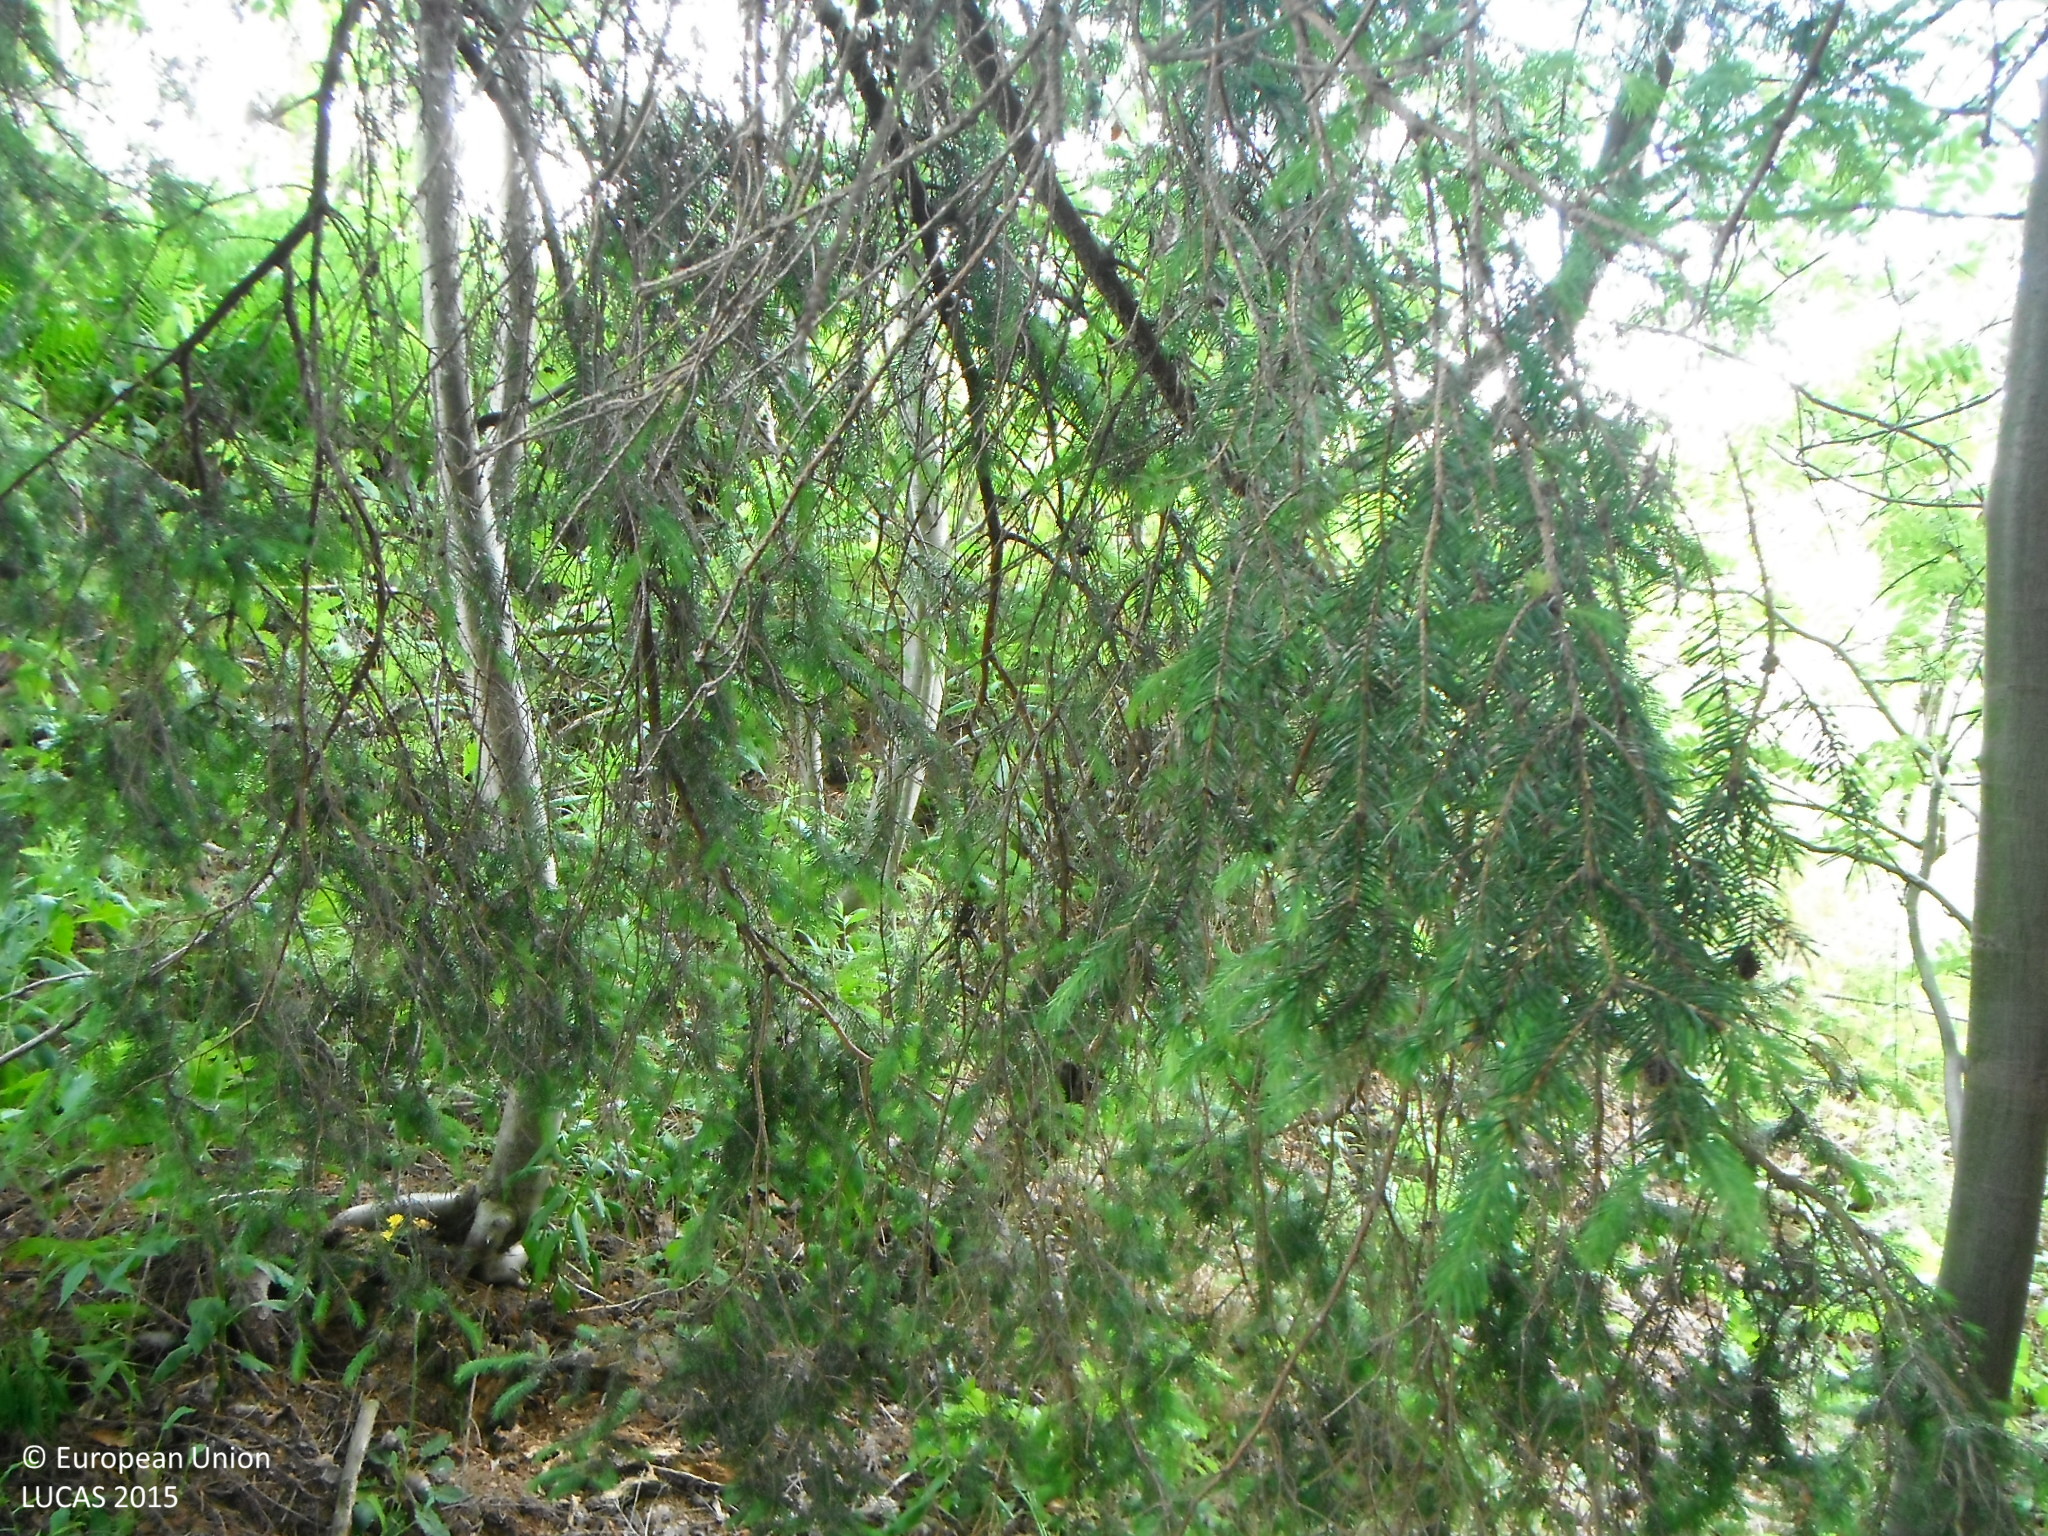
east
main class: Woodland
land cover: Spruce dominated coniferous woodland
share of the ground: > 75 %
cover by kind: coniferous forest trees 90 %, broadleaved forest trees 10 %
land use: Forestry
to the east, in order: Spruce dominated coniferous woodland; Spontaneously vegetated surfaces; Grassland without tree/shrub cover; Tracks; Grassland without tree/shrub cover; Broadleaved woodland; Grassland without tree/shrub cover
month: July
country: SK
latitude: 49.4074
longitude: 19.2722
